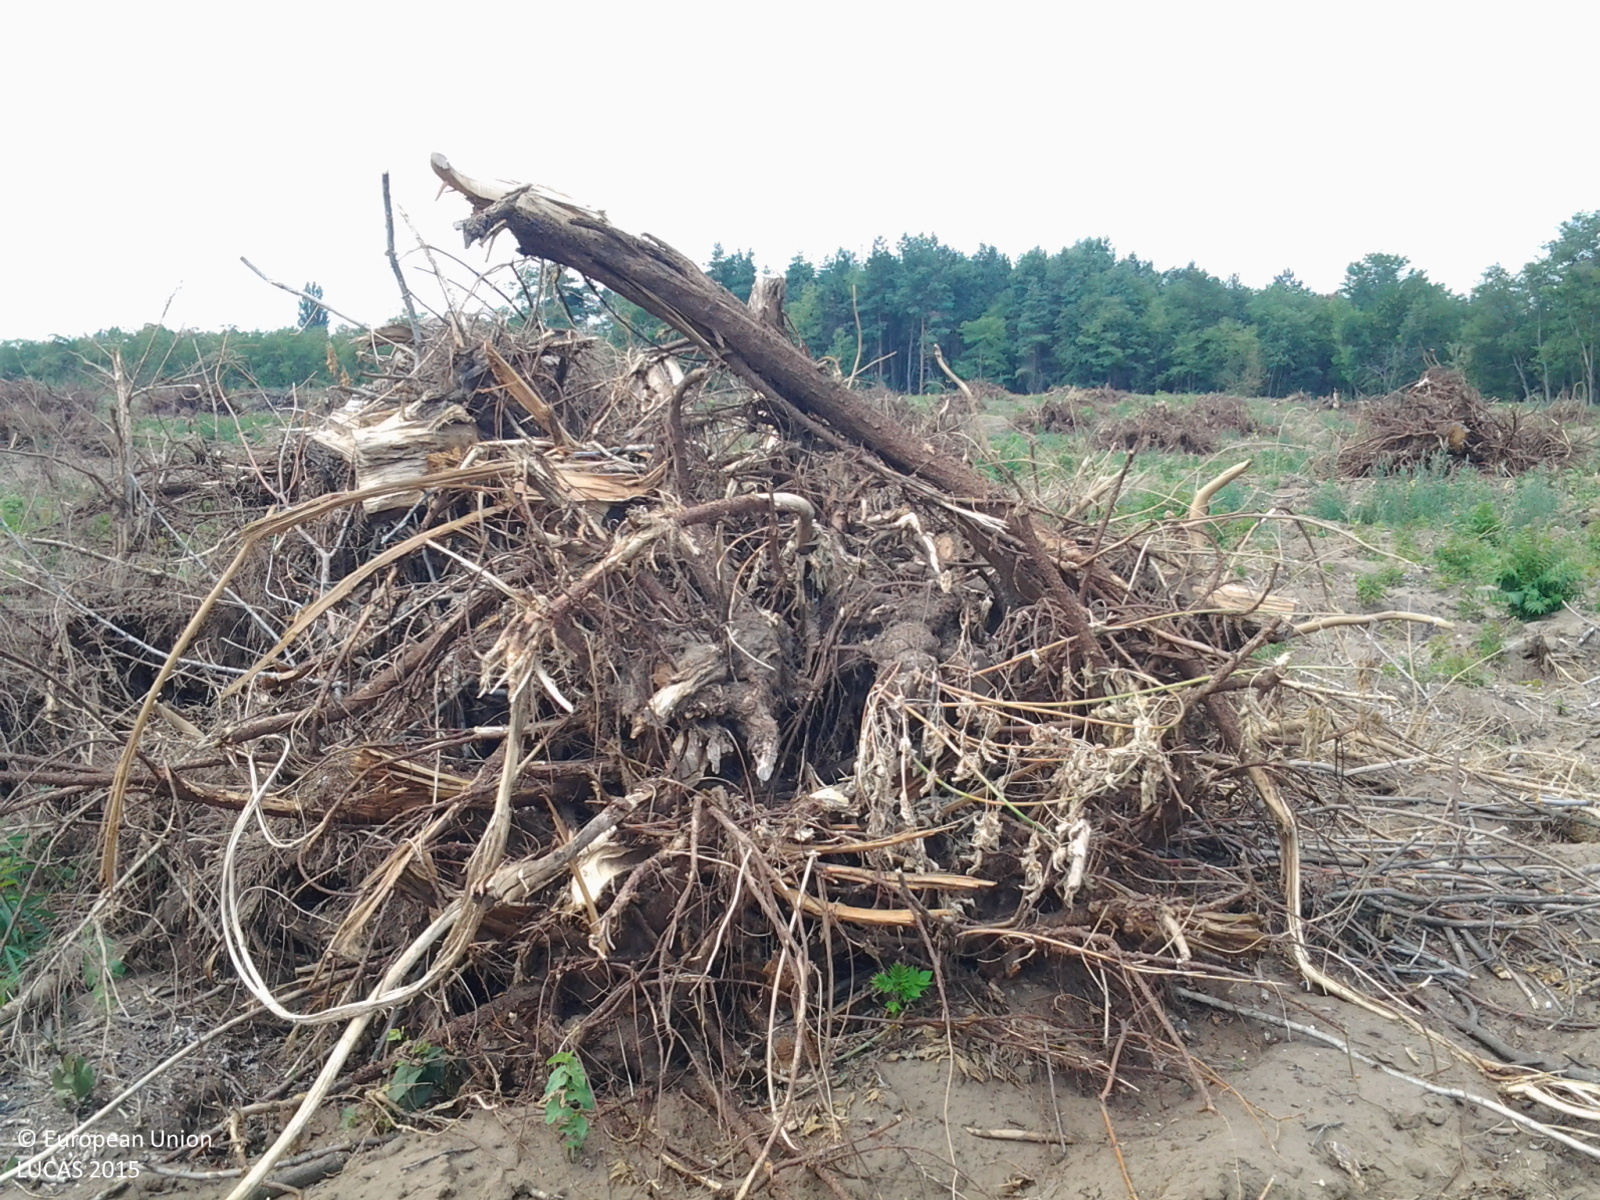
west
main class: Grassland
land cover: Spontaneously vegetated surfaces
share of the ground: 50 - 75 %
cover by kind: herbaceous plants 60 %, unconsolidated bare surface 40 %
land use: Forestry
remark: Clear cut
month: July
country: HU
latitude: 47.4120
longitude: 19.9250
